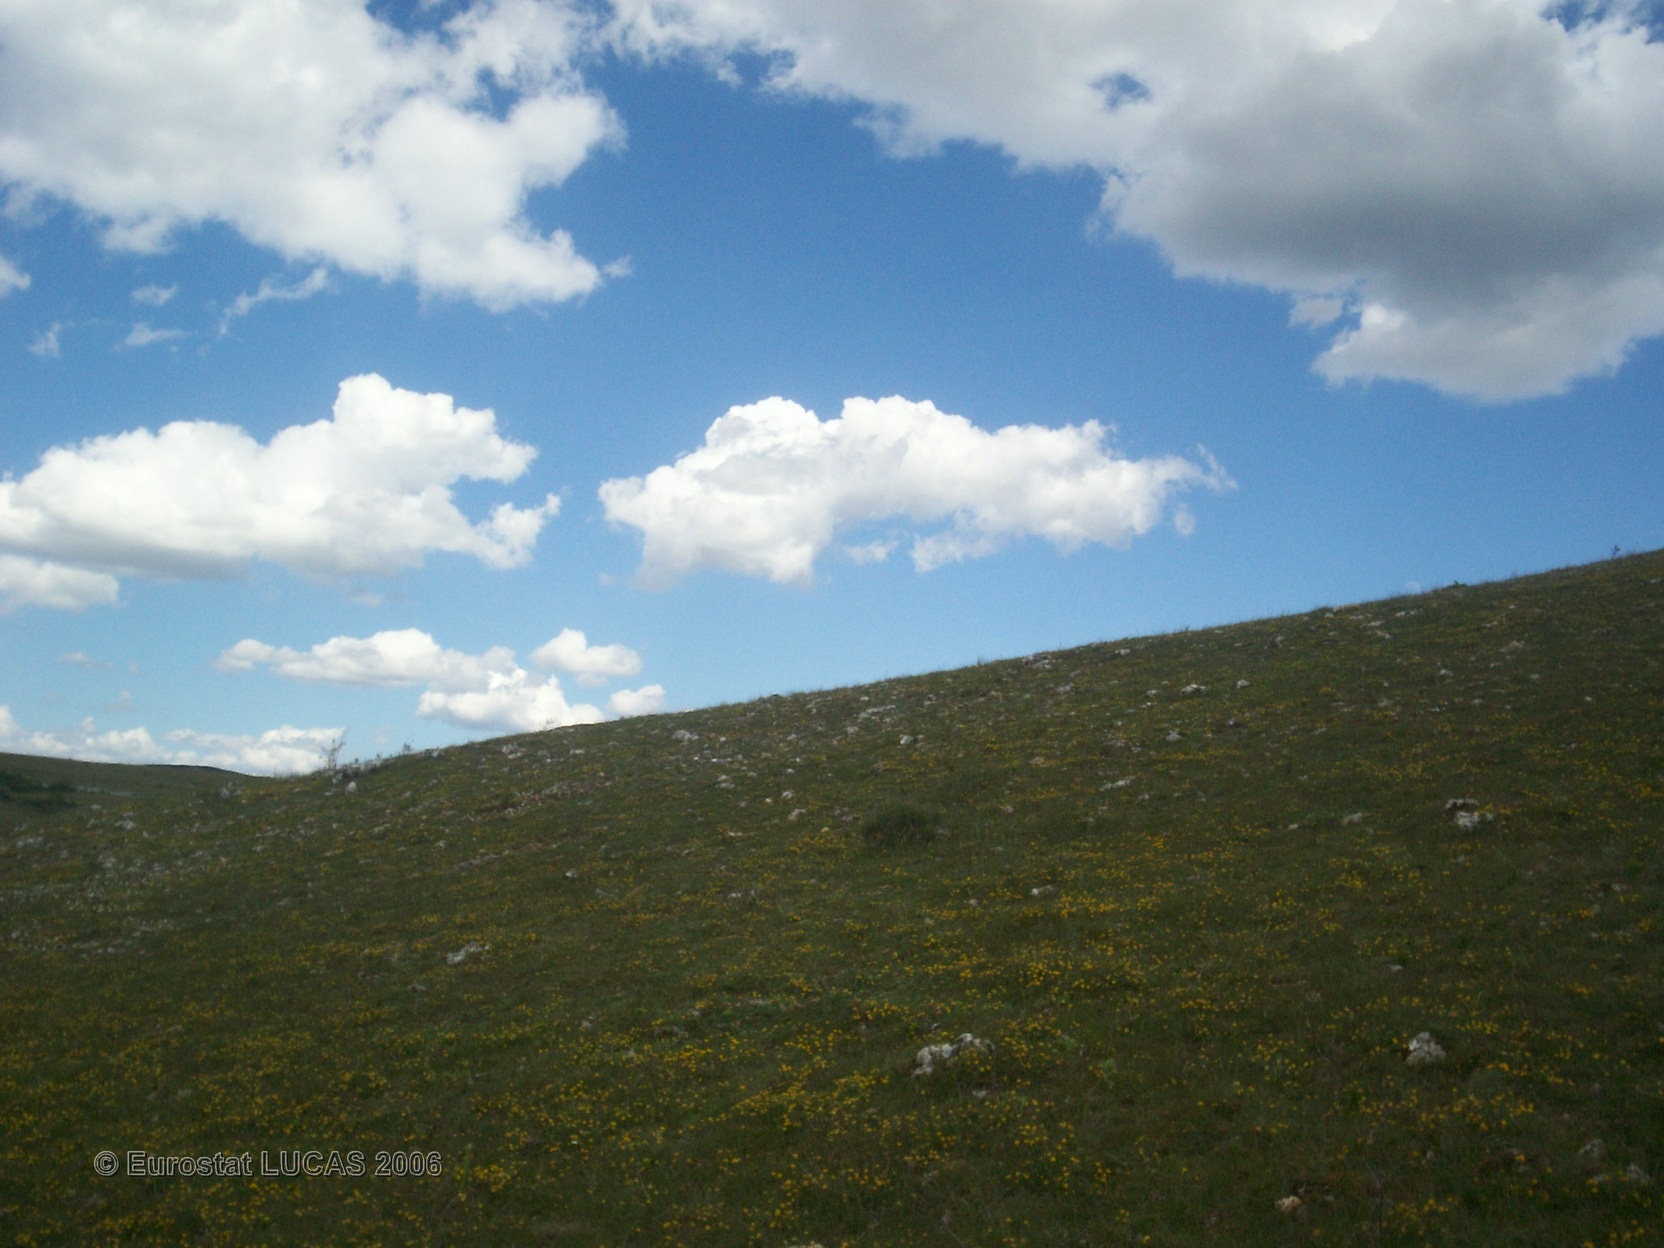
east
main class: Grassland
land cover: Grassland without tree/shrub cover
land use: Agriculture (excluding fallow land and kitchen gardens)
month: June
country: FR
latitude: 44.2329
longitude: 3.4331
